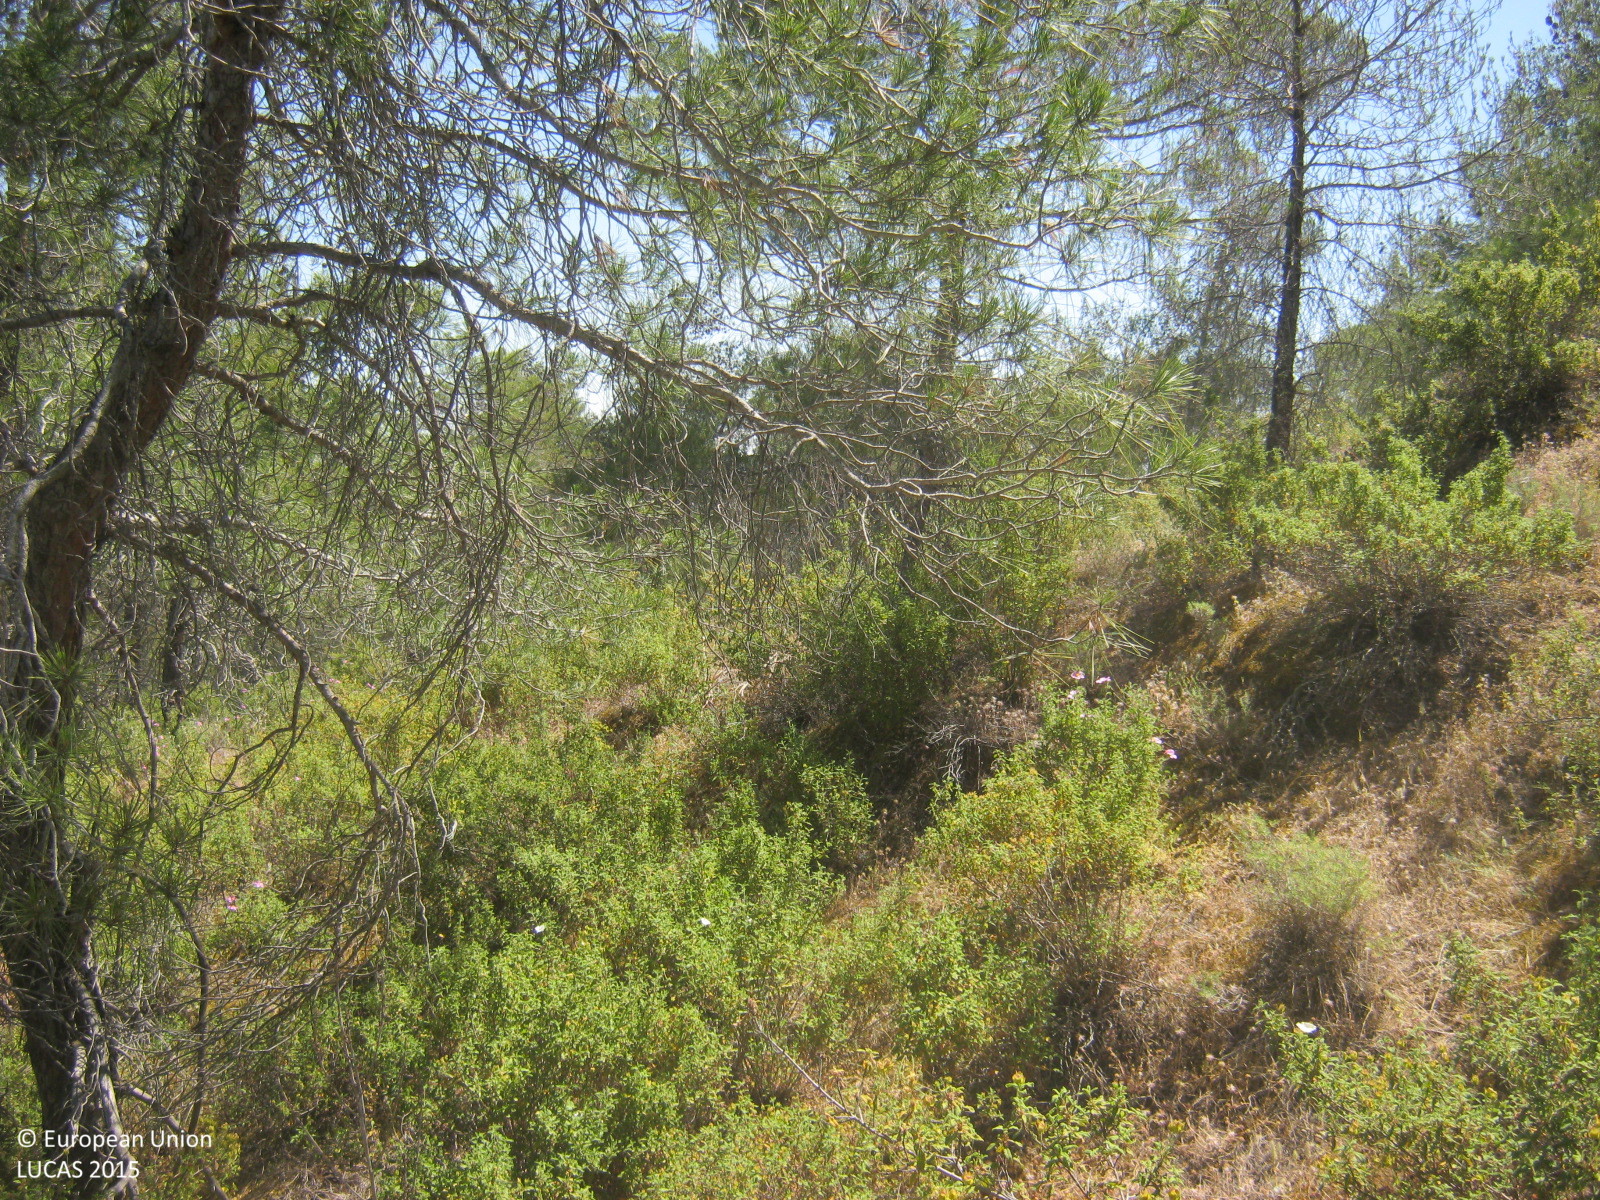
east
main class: Woodland
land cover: Pine dominated coniferous woodland
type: coniferous forest of the mediterranean region
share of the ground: > 75 %
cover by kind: coniferous forest trees 75 %, shrubs 10 %, herbaceous plants 10 %, unconsolidated bare surface 5 %
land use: Forestry
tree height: > 5 m
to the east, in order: Pine dominated coniferous woodland; Shrubland with sparse tree cover; Rivers and streams; Pine dominated coniferous woodland; Tracks; Spontaneously vegetated surfaces
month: May
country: CY
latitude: 34.9989
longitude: 33.2245
